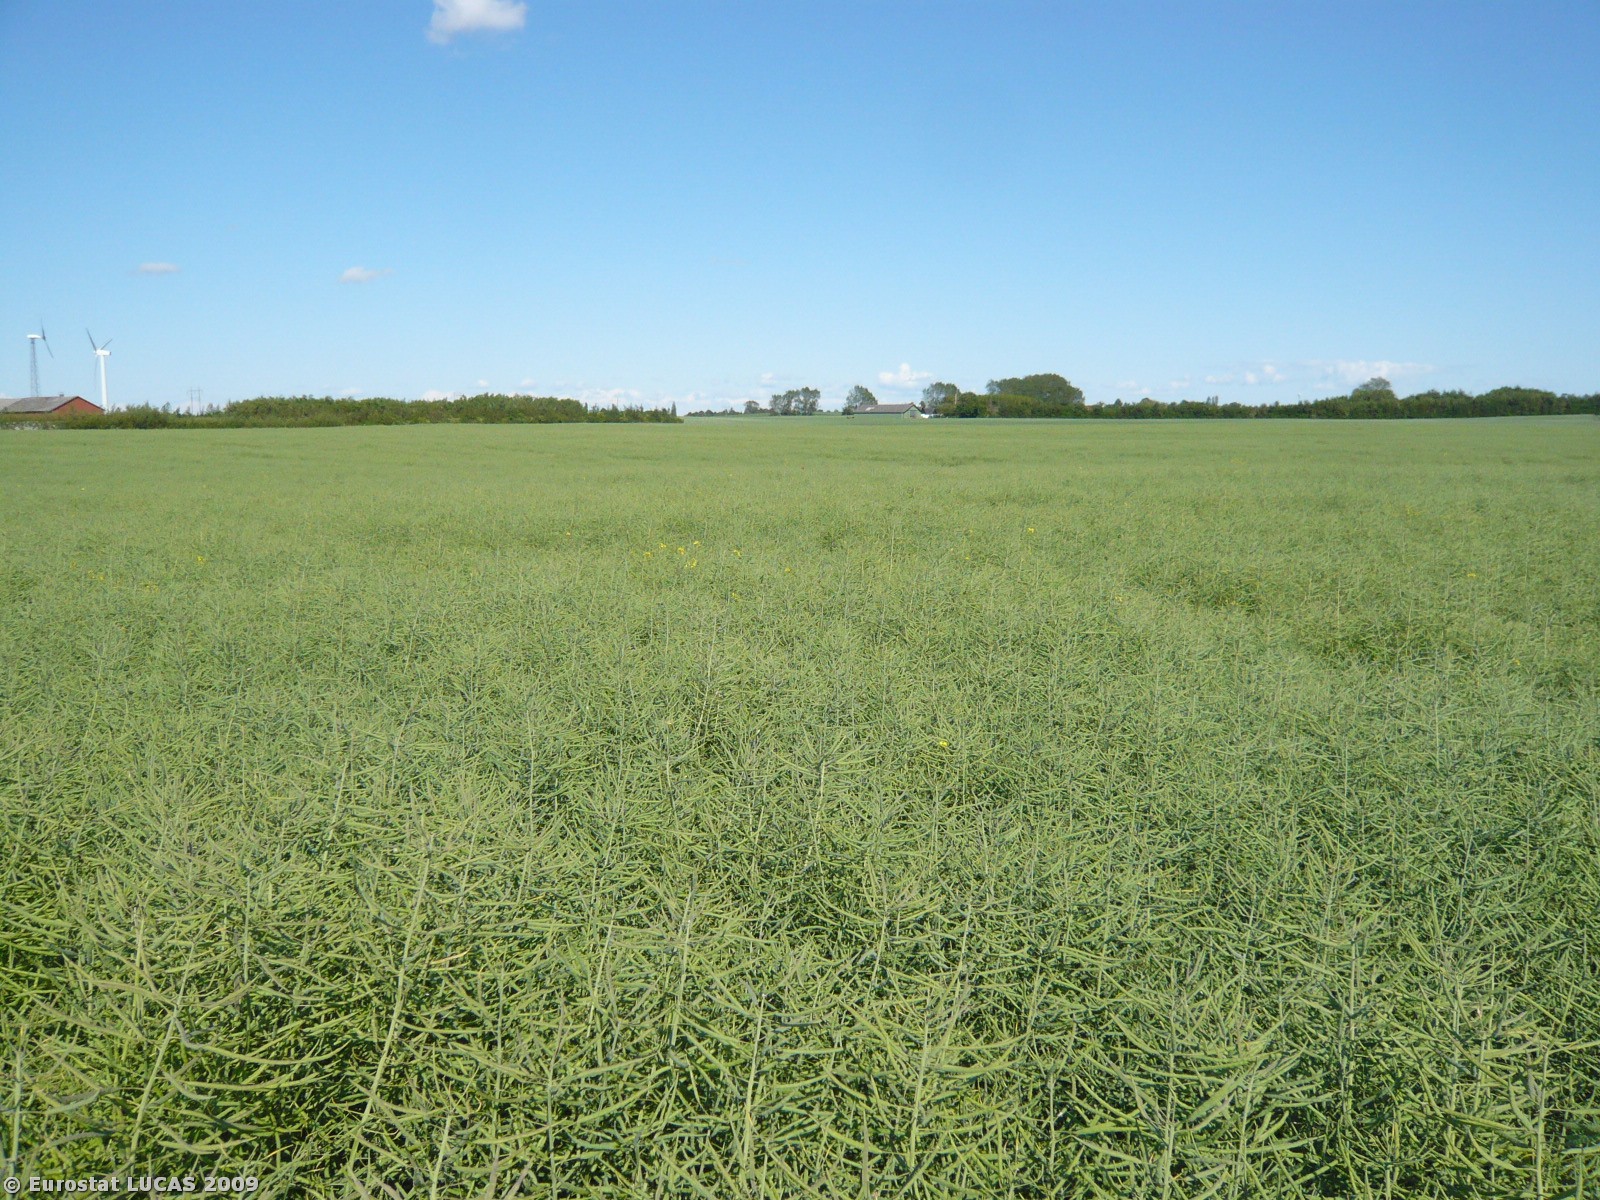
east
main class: Cropland
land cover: Rape and turnip rape
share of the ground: > 75 %
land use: Agriculture (excluding fallow land and kitchen gardens)
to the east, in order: Rape and turnip rape
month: June
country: DK
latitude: 55.3191
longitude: 11.2124
